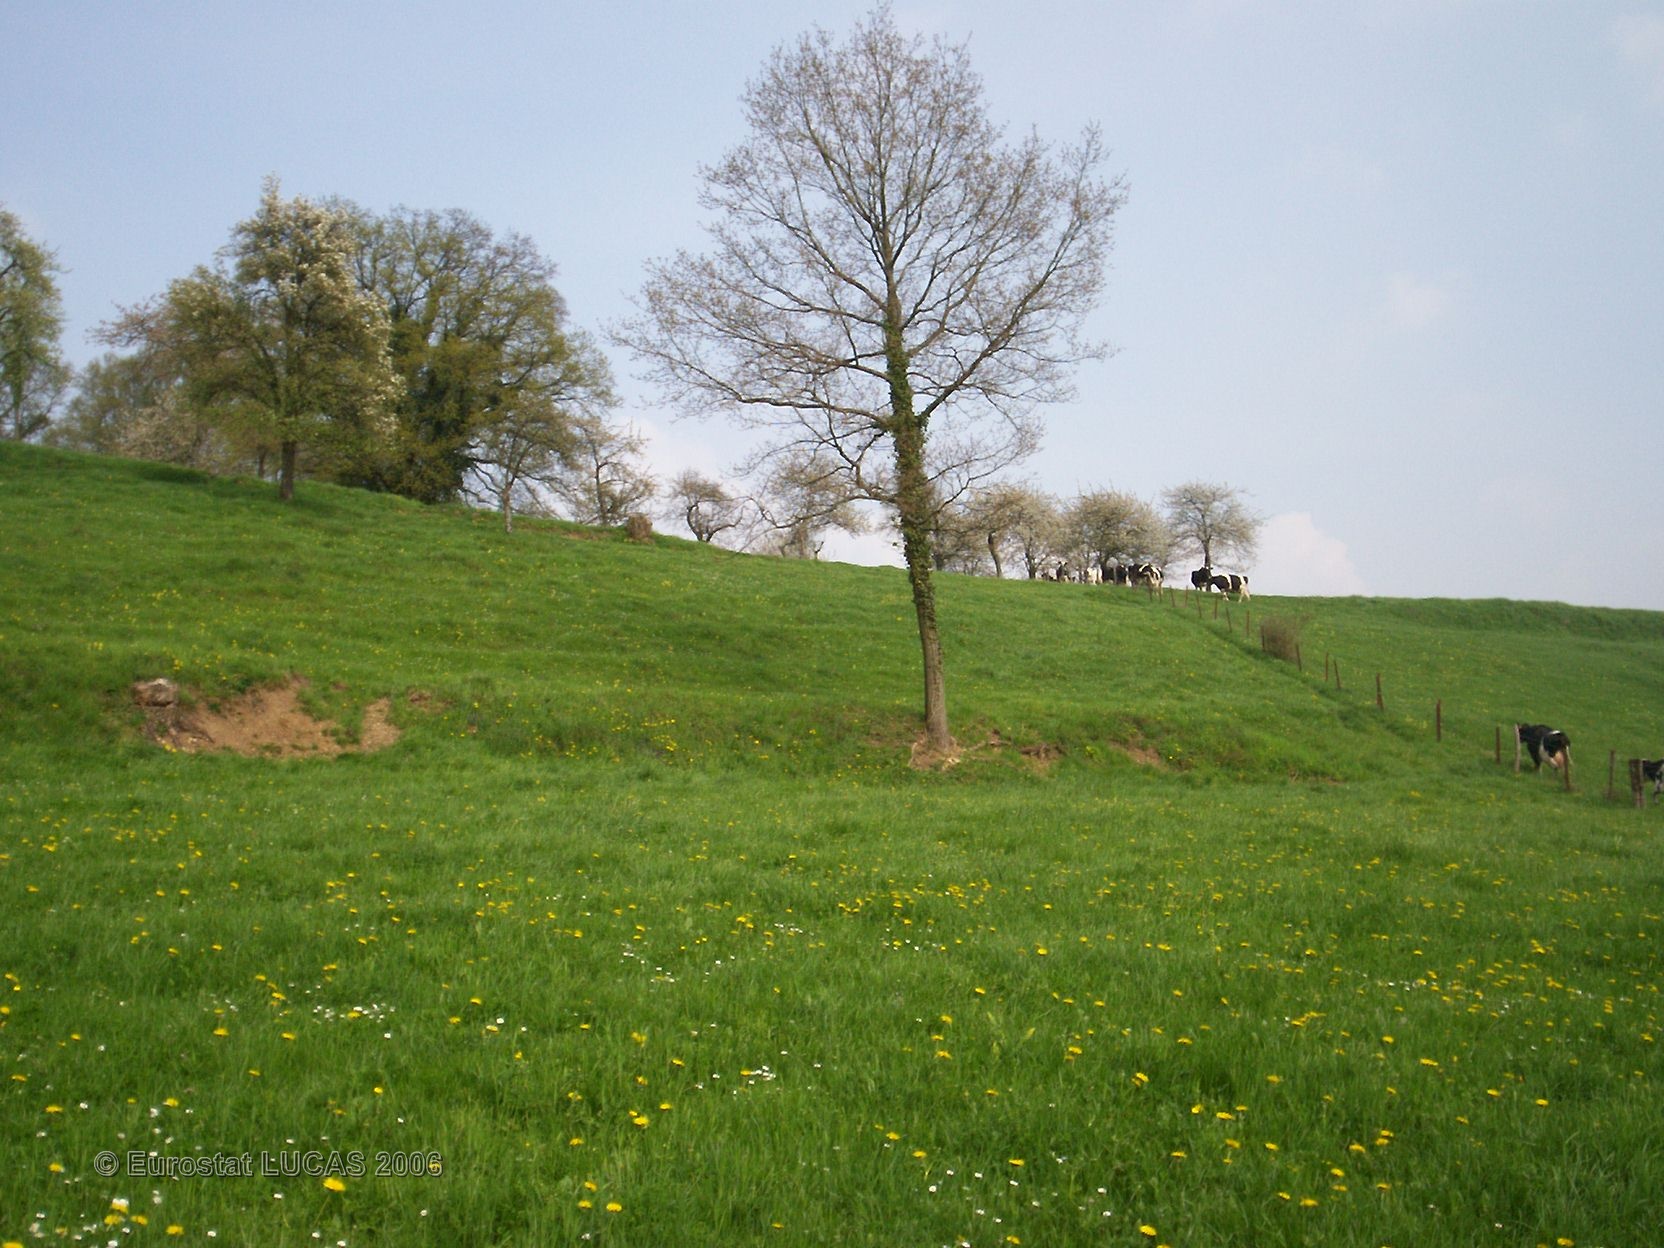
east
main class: Grassland
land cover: Grassland without tree/shrub cover
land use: Agriculture (excluding fallow land and kitchen gardens)
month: April
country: FR
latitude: 49.5679
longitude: 4.5623
